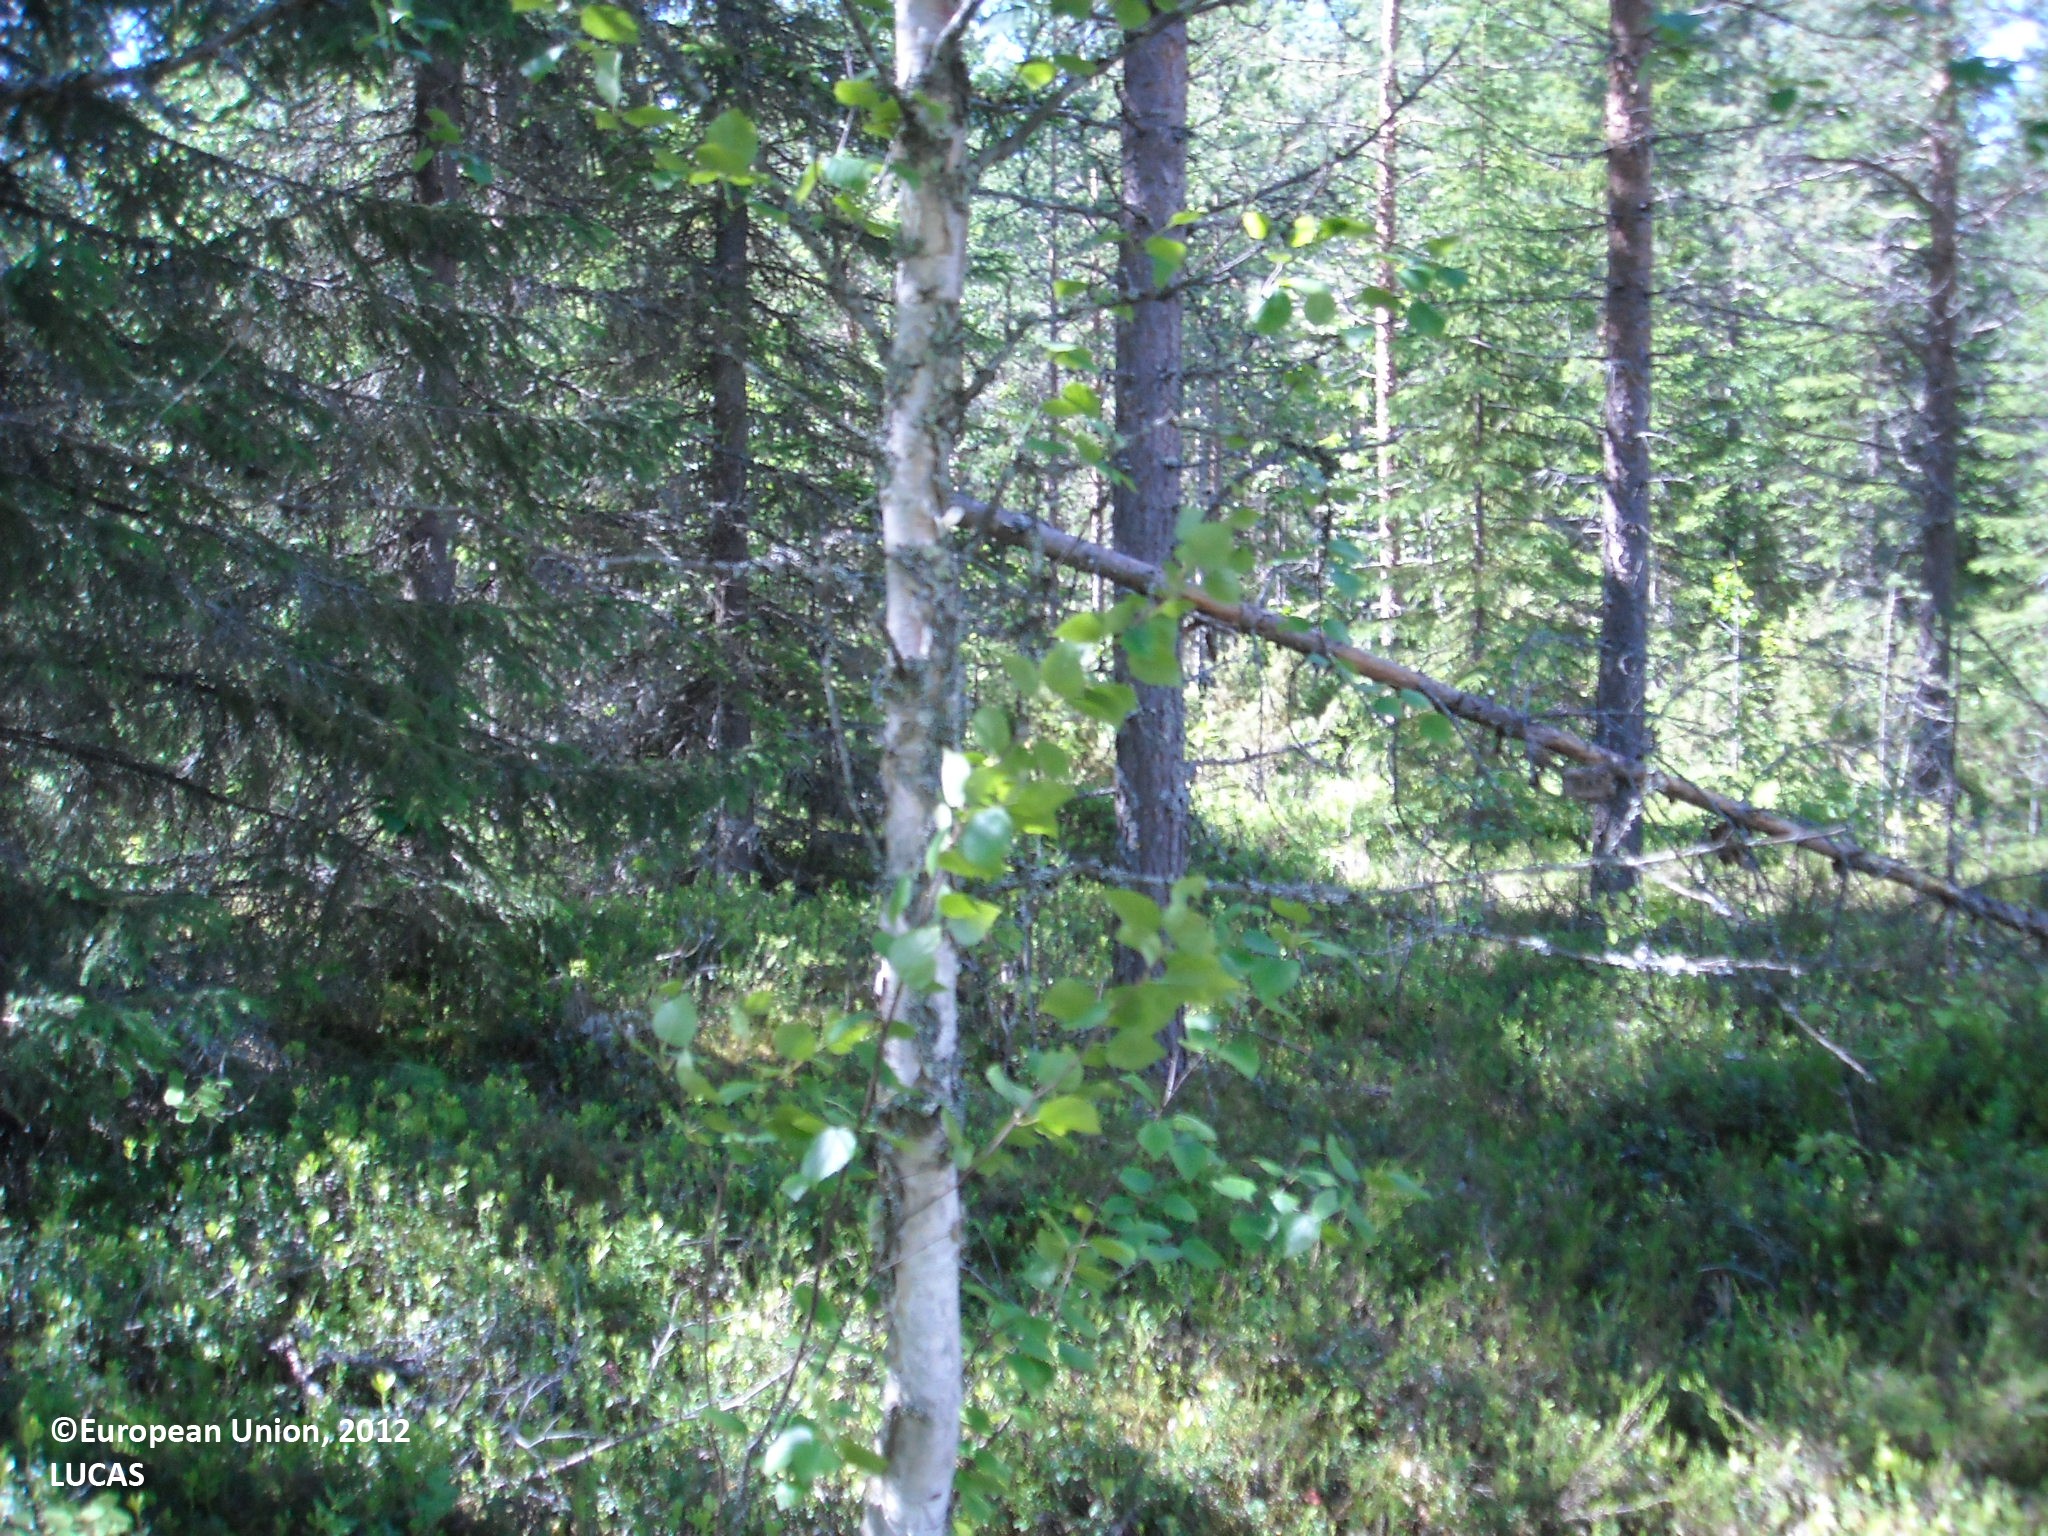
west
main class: Woodland
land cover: Other coniferous woodland
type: boreal forest
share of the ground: > 75 %
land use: Forestry
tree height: > 5 m
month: July
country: FI
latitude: 64.7998
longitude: 27.4181
